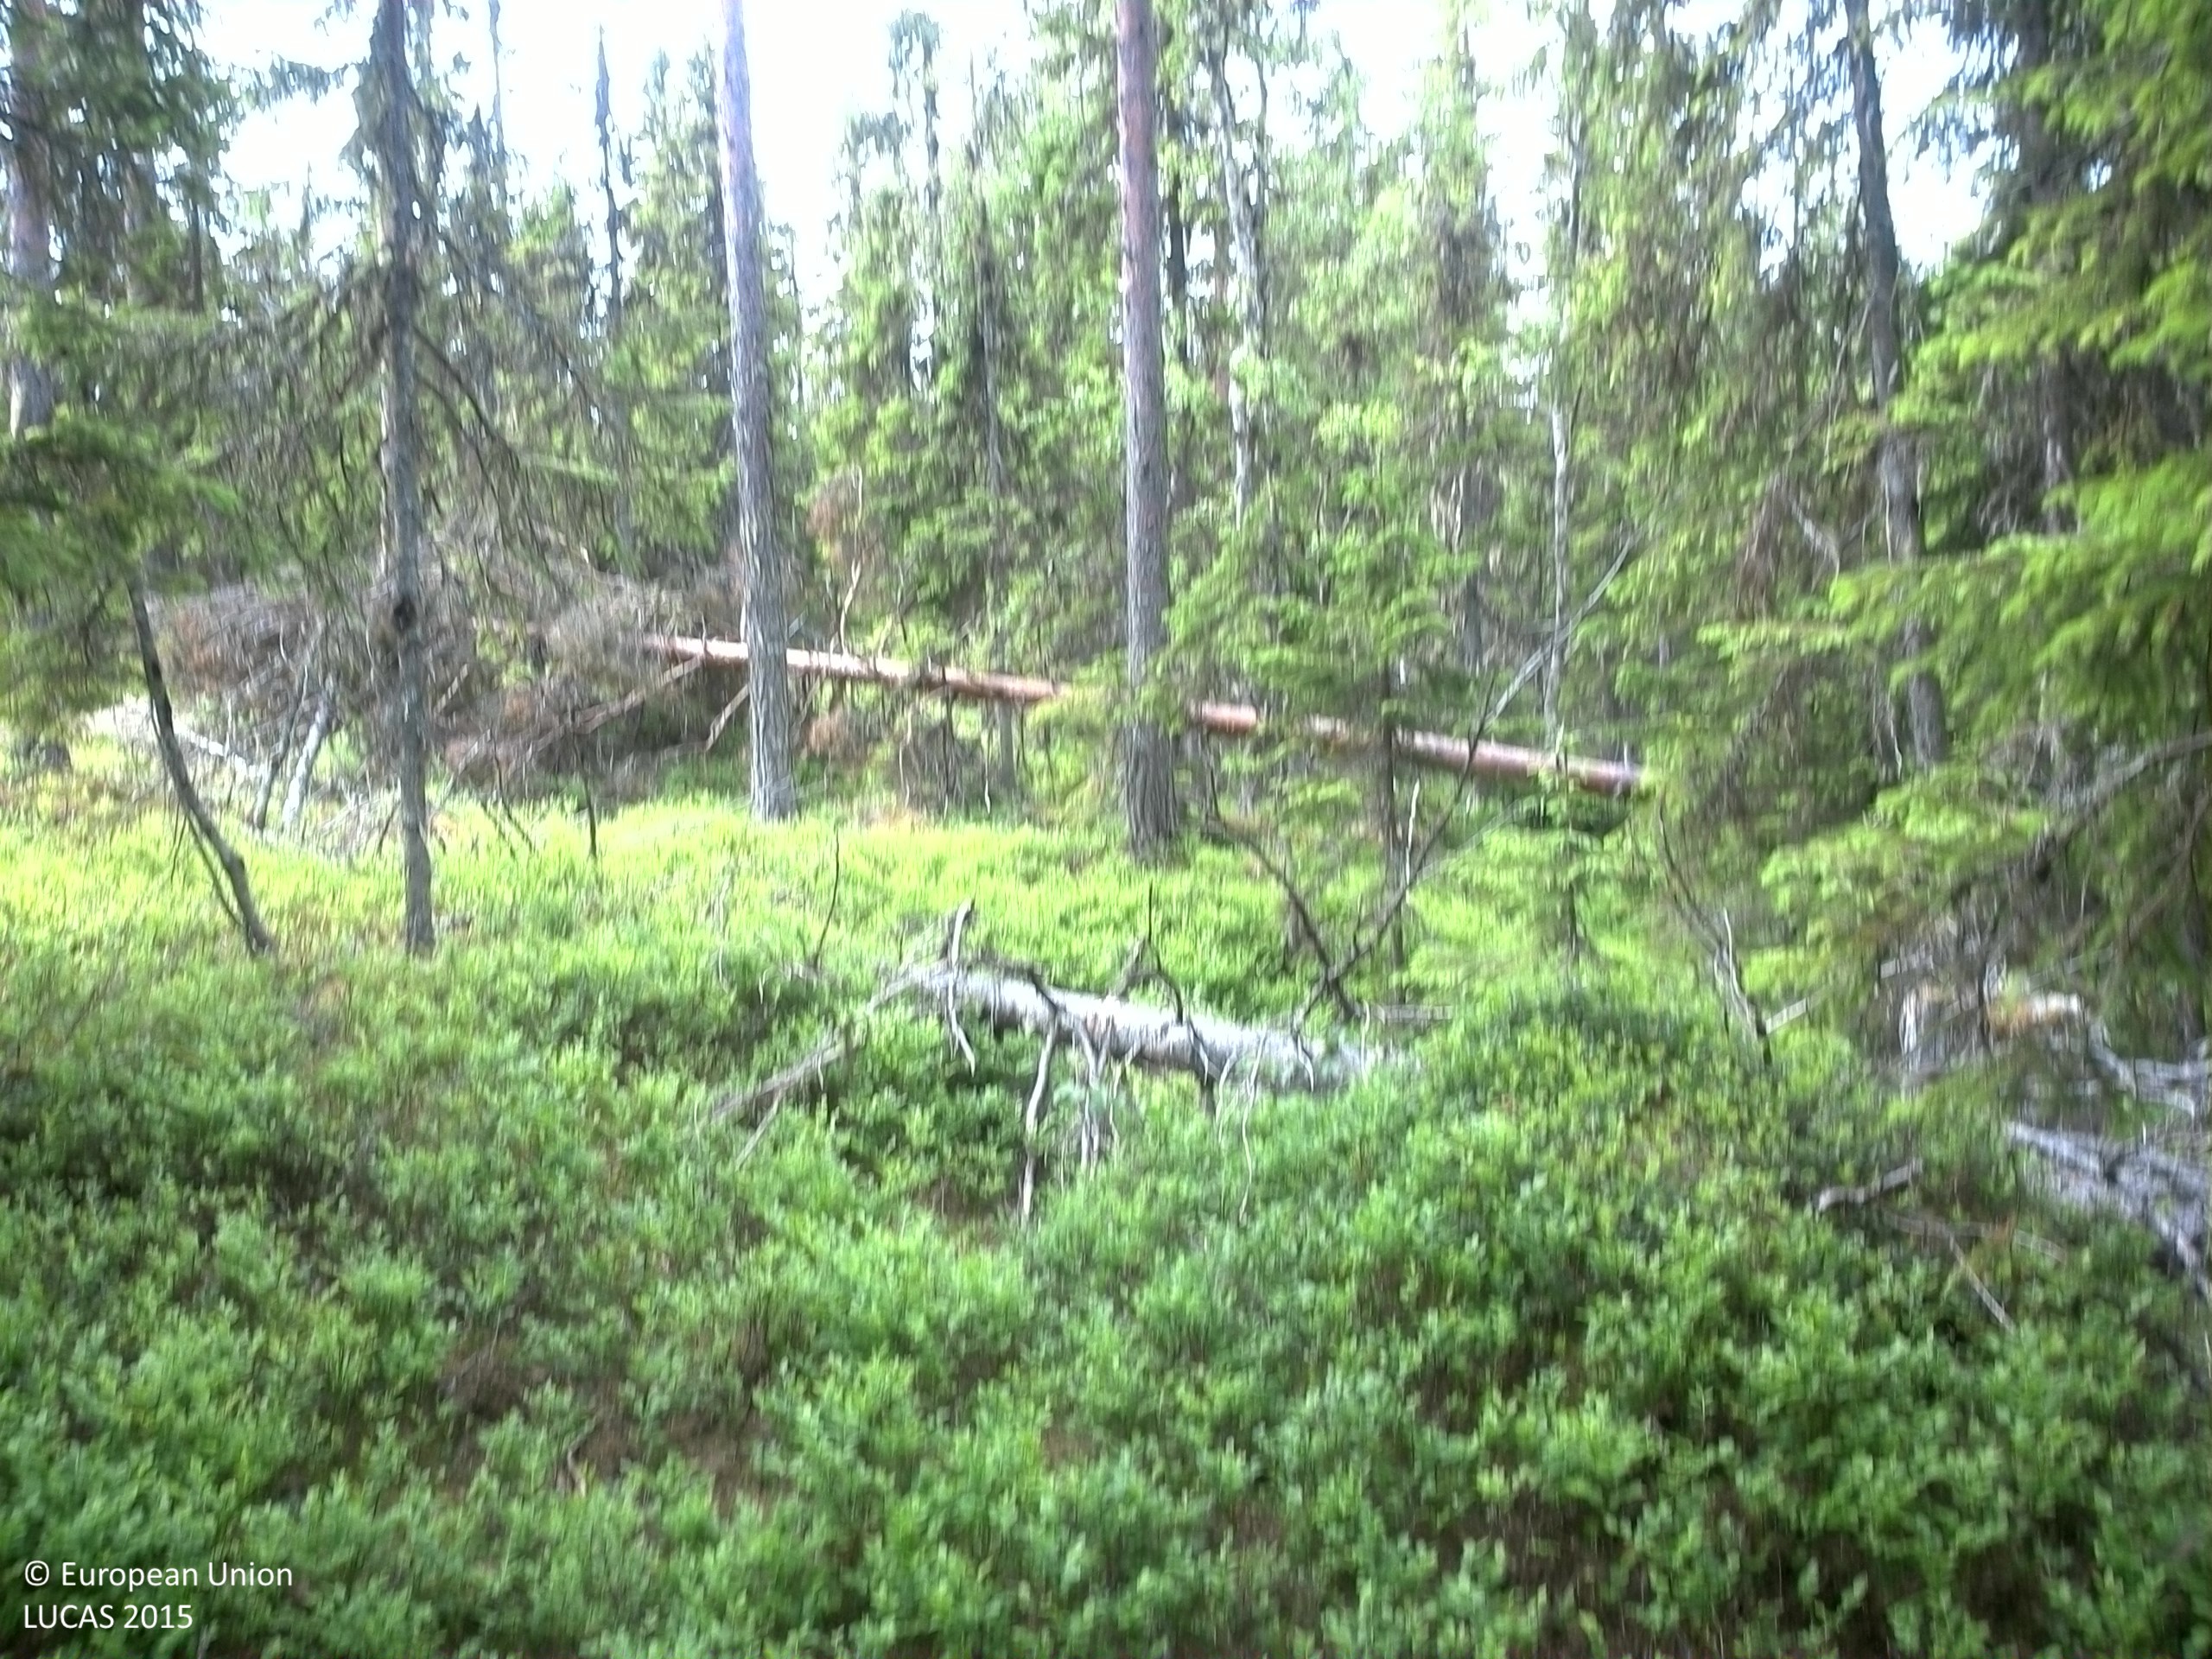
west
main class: Woodland
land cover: Spruce dominated coniferous woodland
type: boreal forest
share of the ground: 50 - 75 %
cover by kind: coniferous forest trees 60 %, shrubs 30 %, broadleaved forest trees 10 %
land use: Forestry
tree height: > 5 m
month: June
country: SE
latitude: 62.8544
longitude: 17.6205
